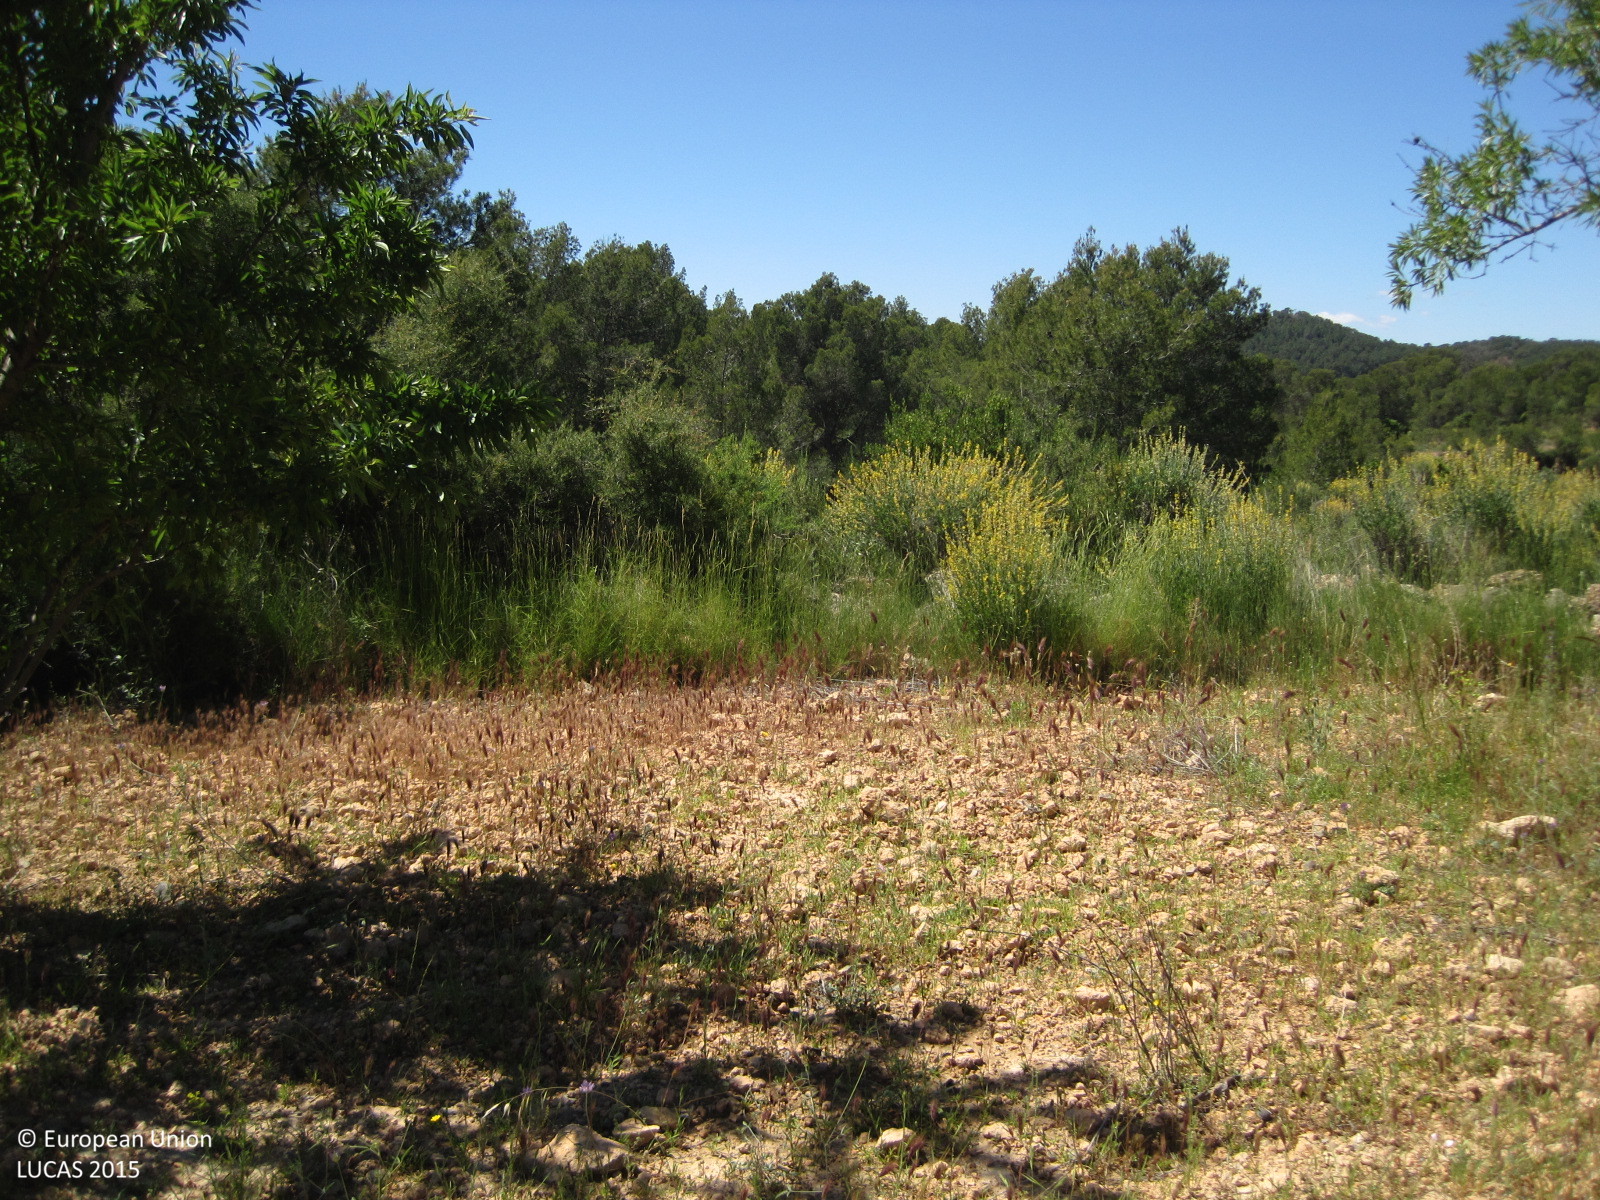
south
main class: Cropland
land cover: Nuts trees
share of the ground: 10 - 25 %
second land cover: Spontaneously vegetated surfaces
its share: > 75 %
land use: Agriculture (excluding fallow land and kitchen gardens)
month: May
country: ES
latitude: 39.7503
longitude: -0.7275
